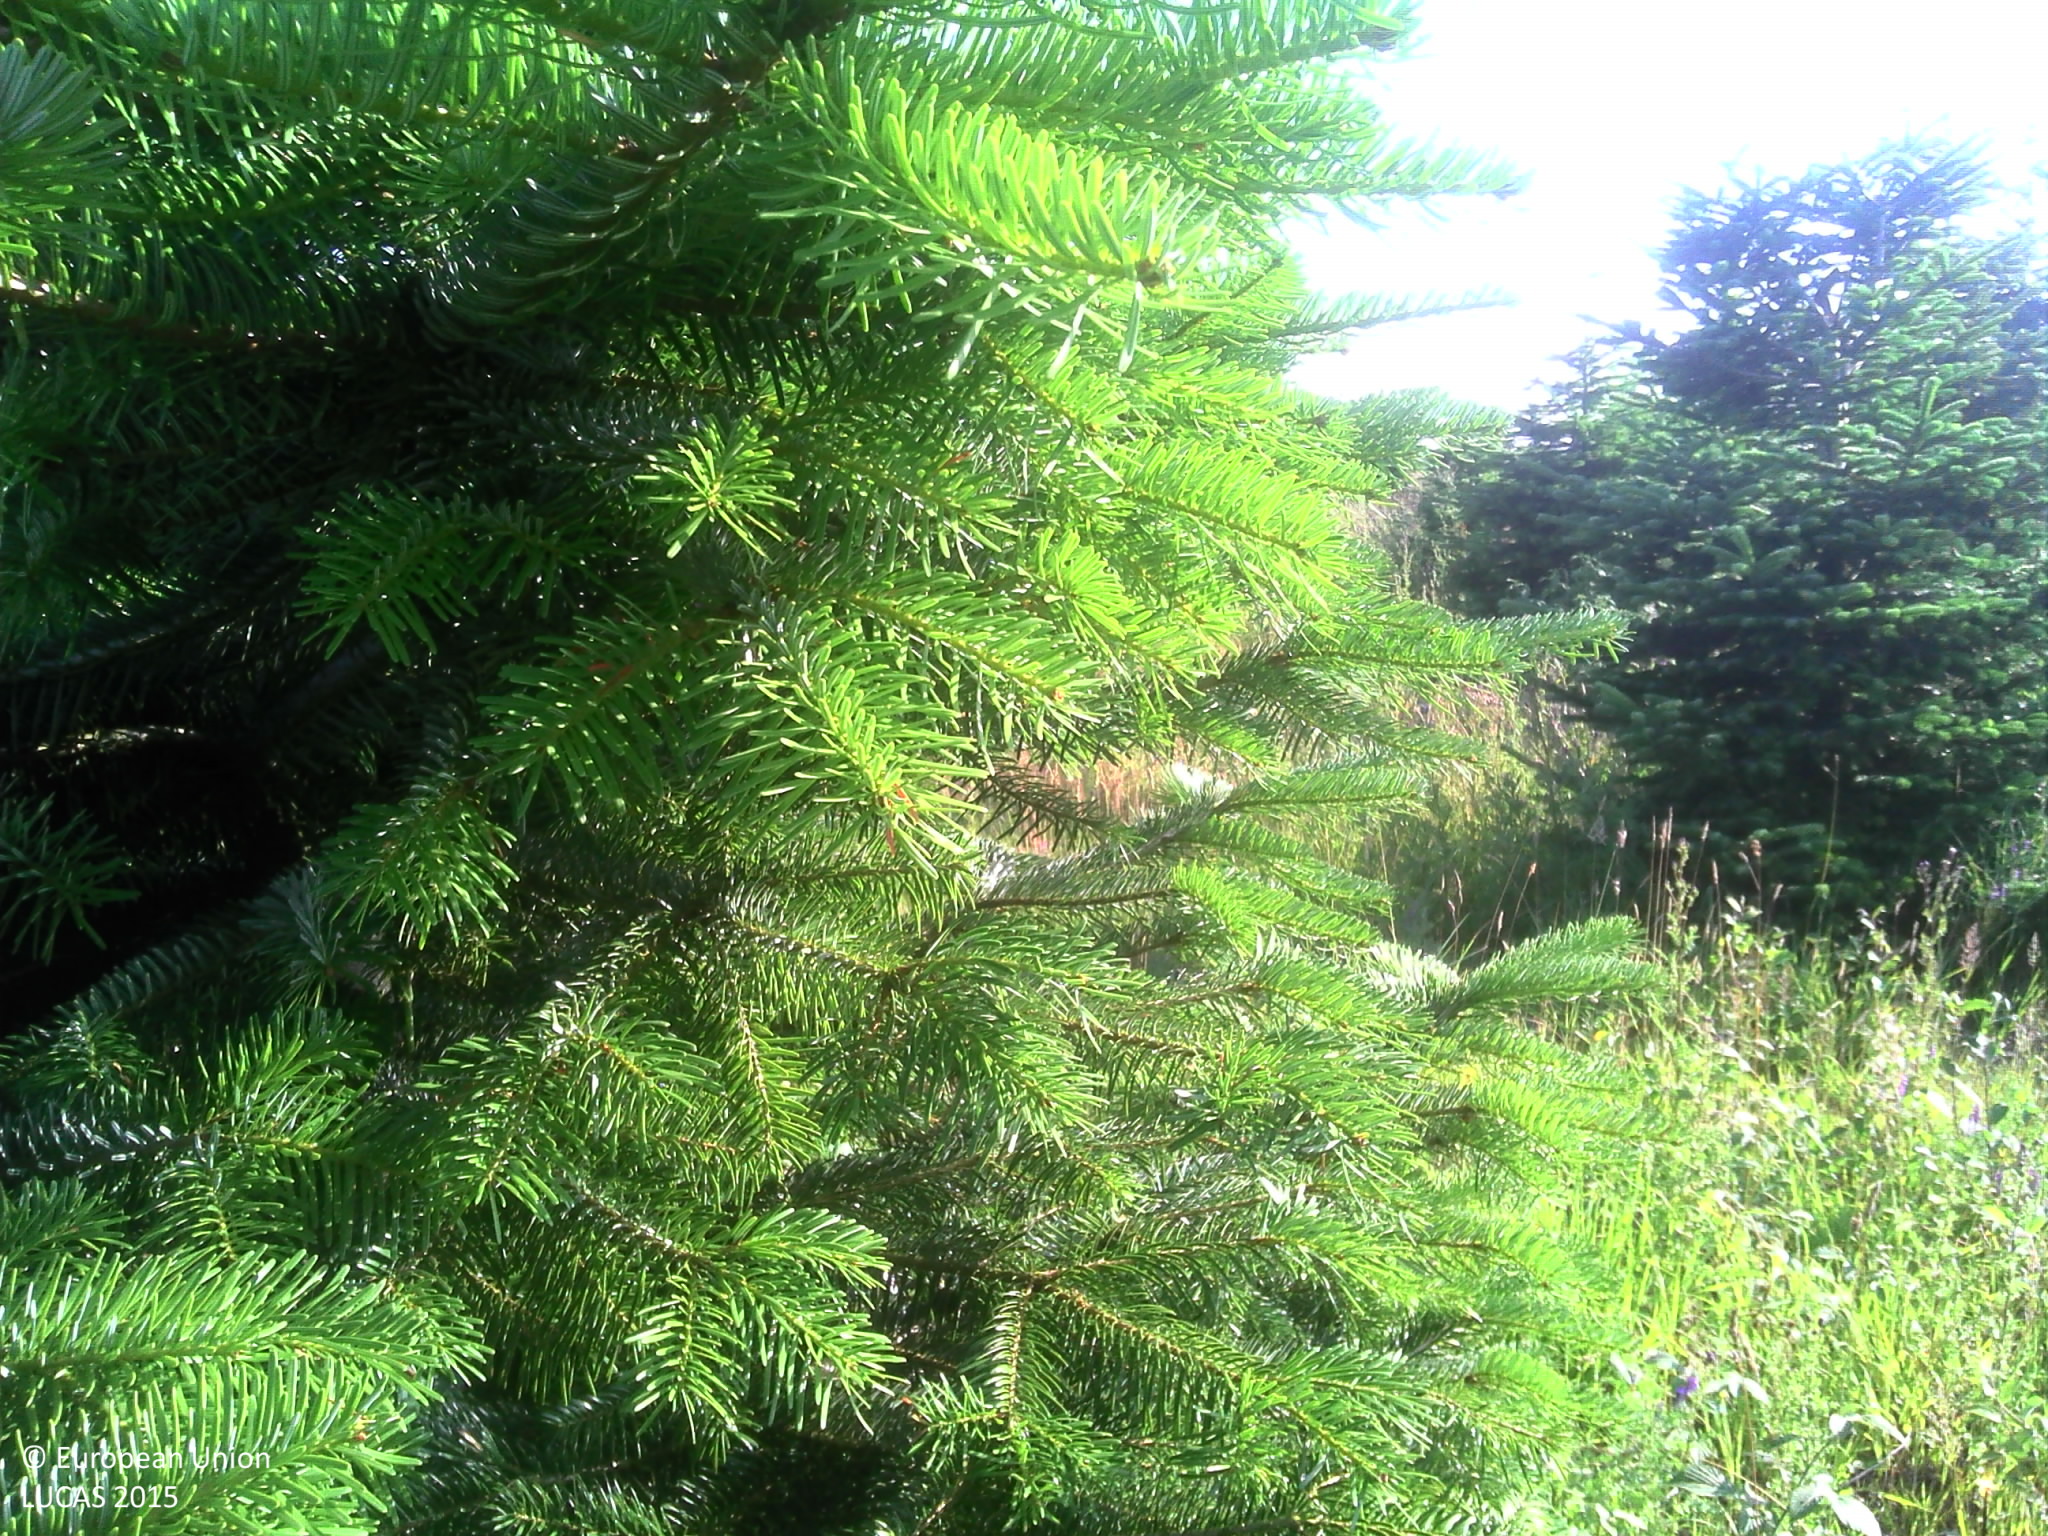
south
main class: Cropland
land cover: Nurseries
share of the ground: > 75 %
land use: Forestry
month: July
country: BE
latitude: 49.8996
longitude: 5.5573
